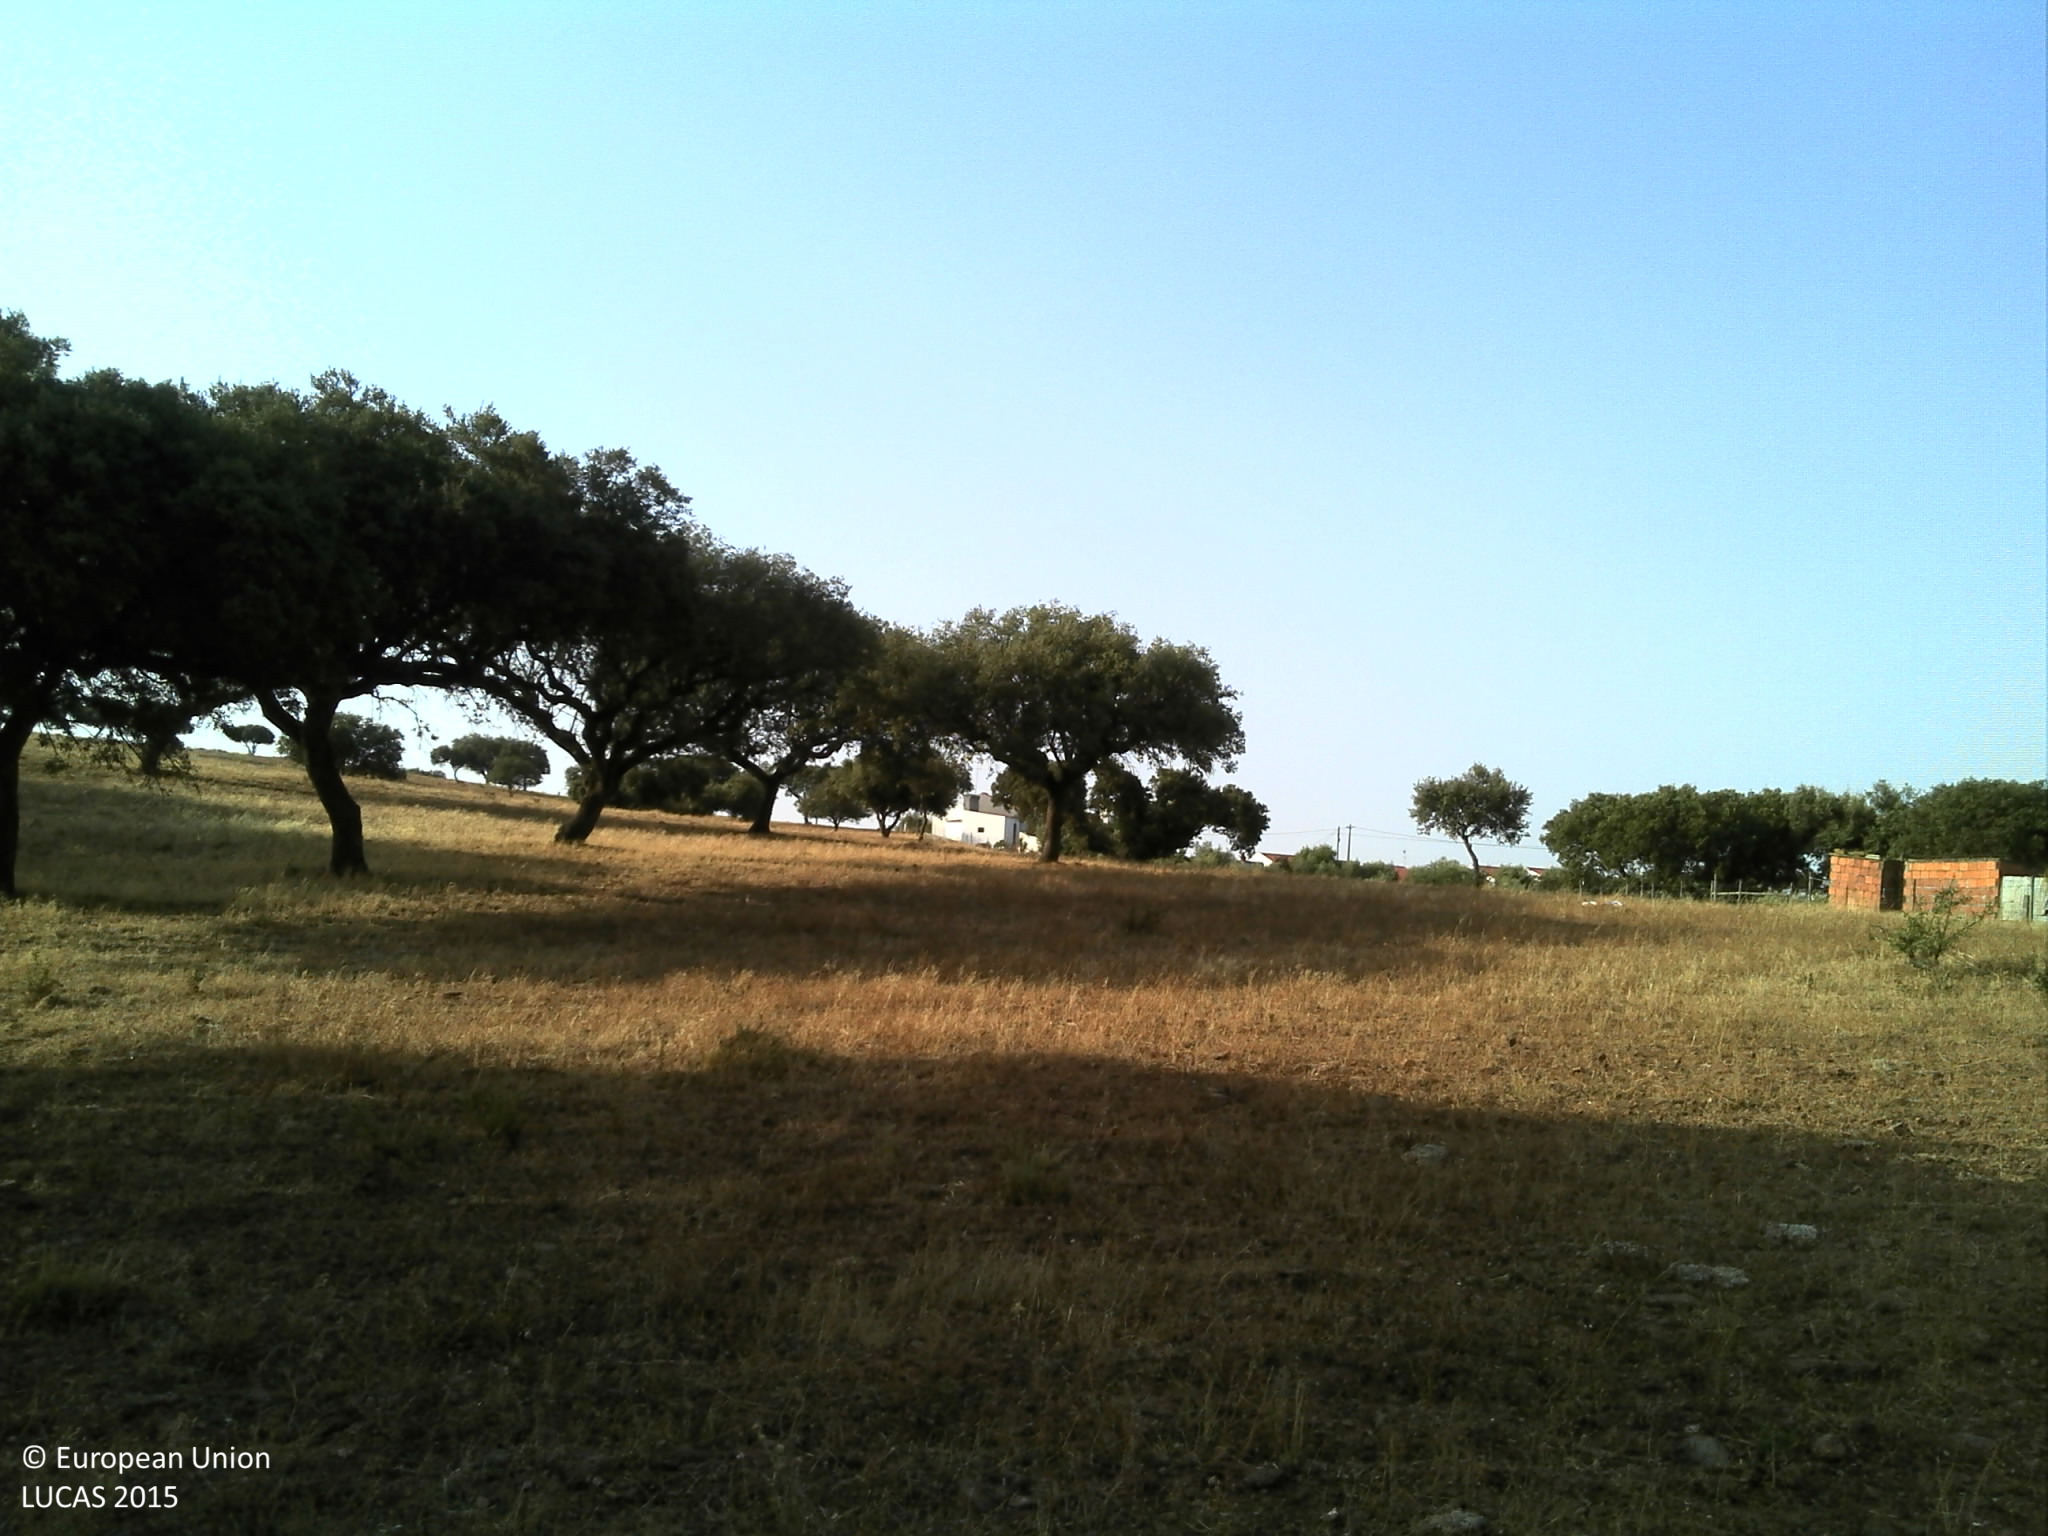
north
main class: Woodland
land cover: Broadleaved woodland
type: broadleaved evergreen forest
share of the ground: 10 - 25 %
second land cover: Grassland without tree/shrub cover
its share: 10 - 25 %
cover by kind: unconsolidated bare surface 80 %, broadleaved forest trees 10 %, herbaceous plants 10 %
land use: Forestry
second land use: Agriculture (excluding fallow land and kitchen gardens)
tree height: > 5 m
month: July
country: PT
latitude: 38.6754
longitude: -7.3269
